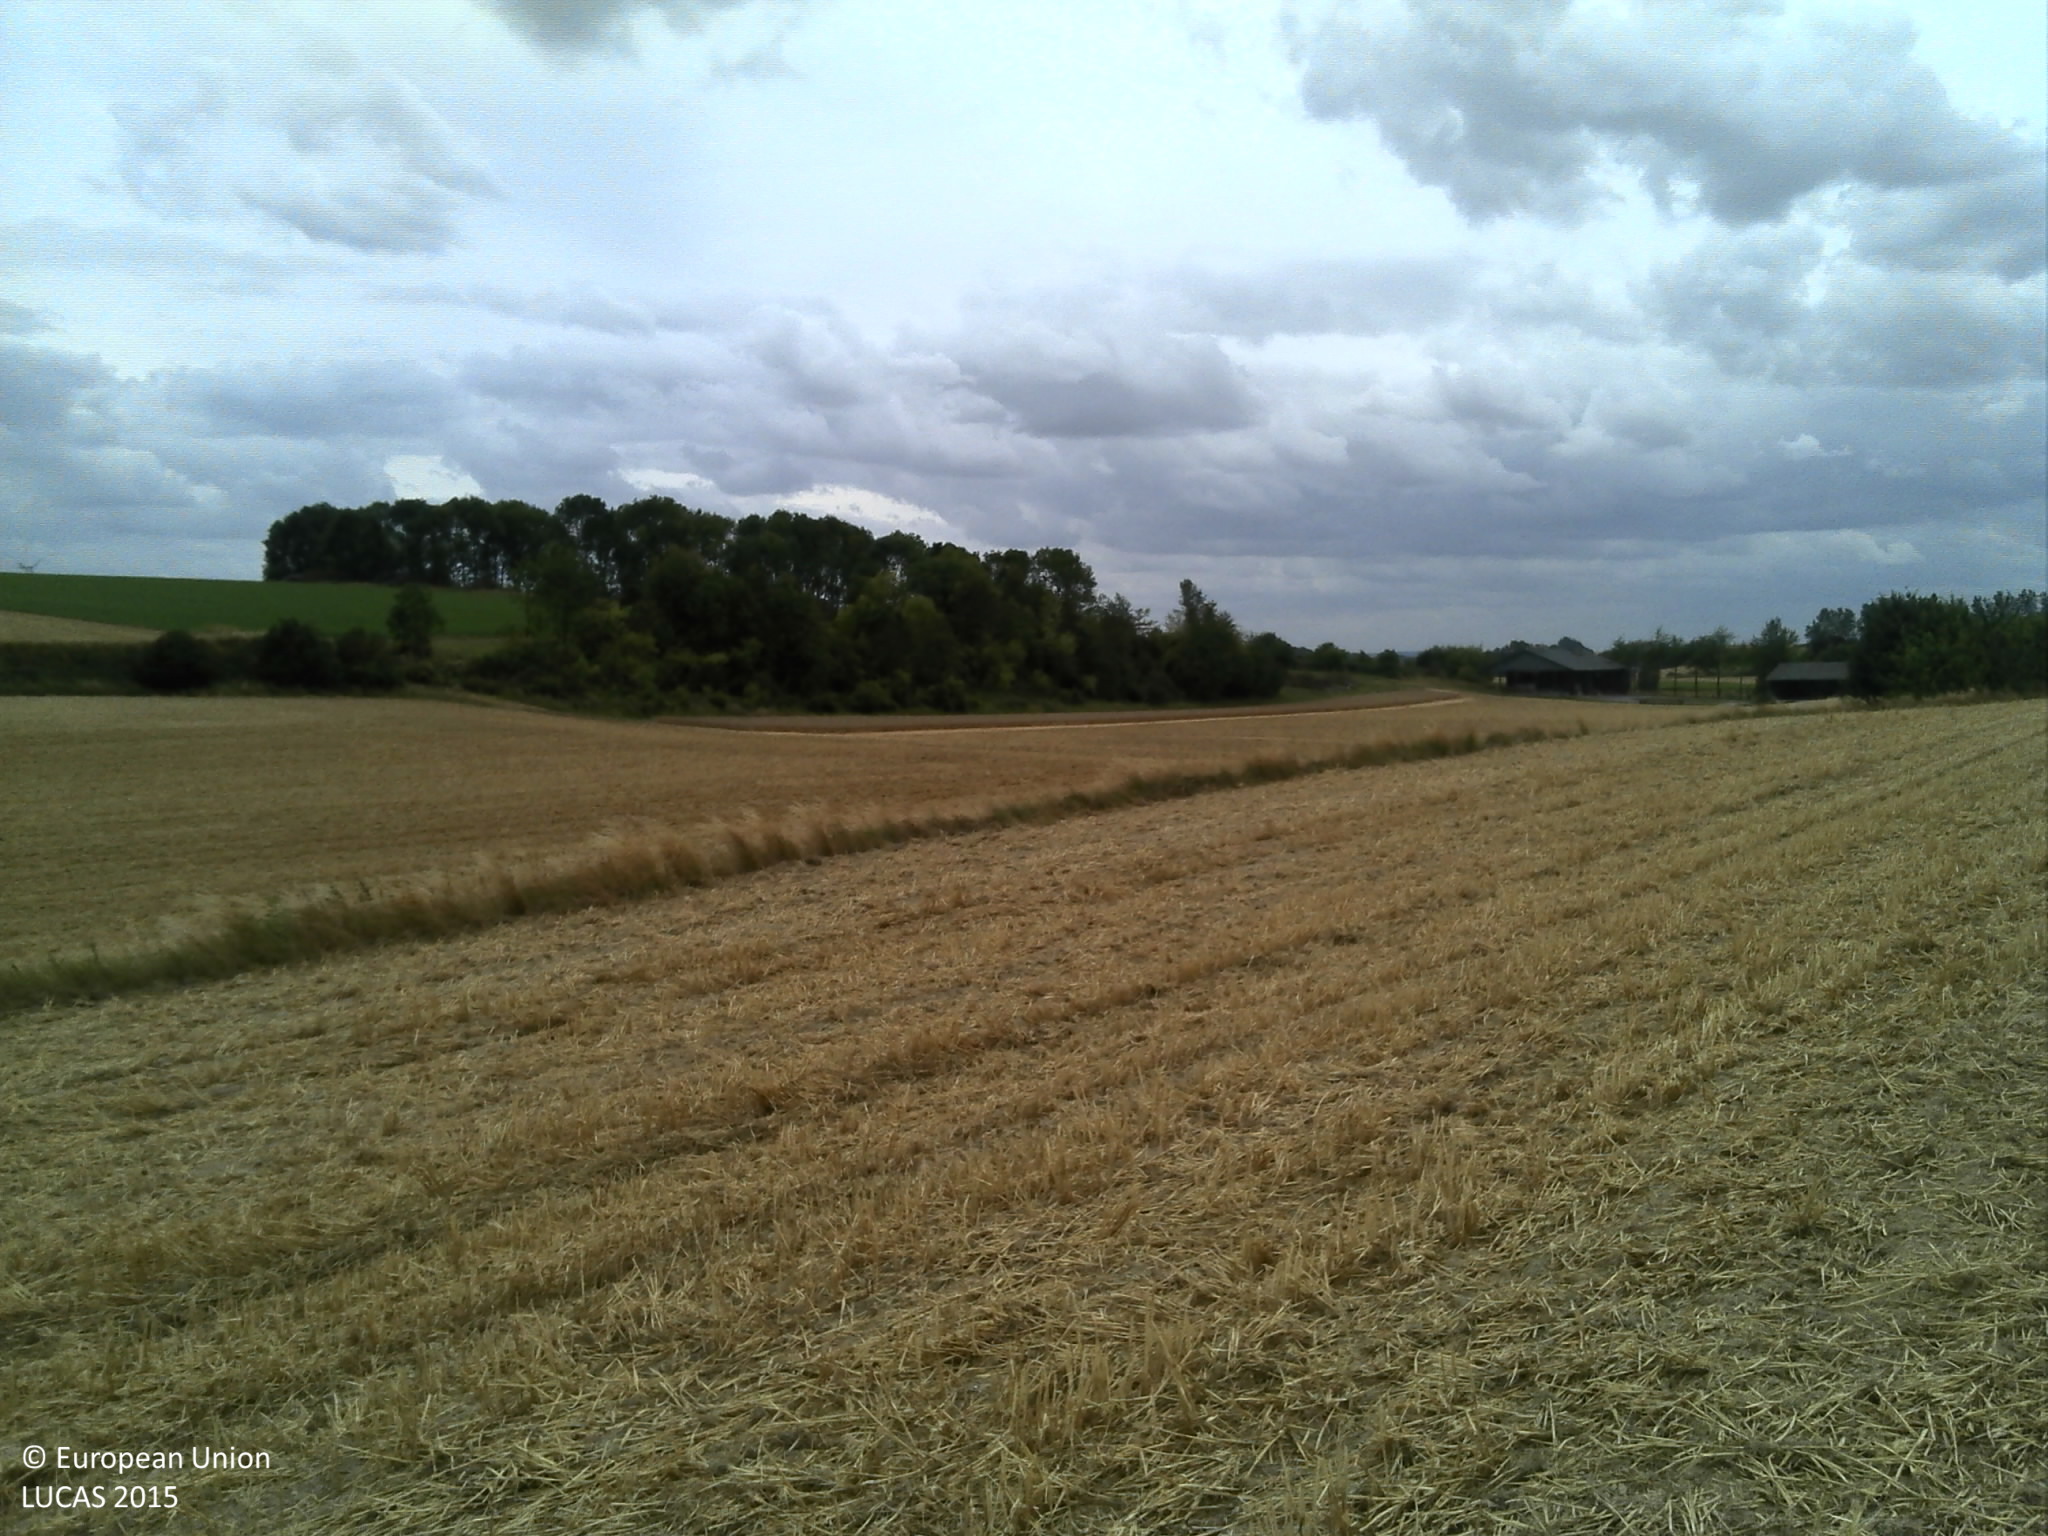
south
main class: Cropland
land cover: Common wheat
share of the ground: 25 - 50 %
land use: Agriculture (excluding fallow land and kitchen gardens)
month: July
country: FR
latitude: 49.5980
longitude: 4.0871
